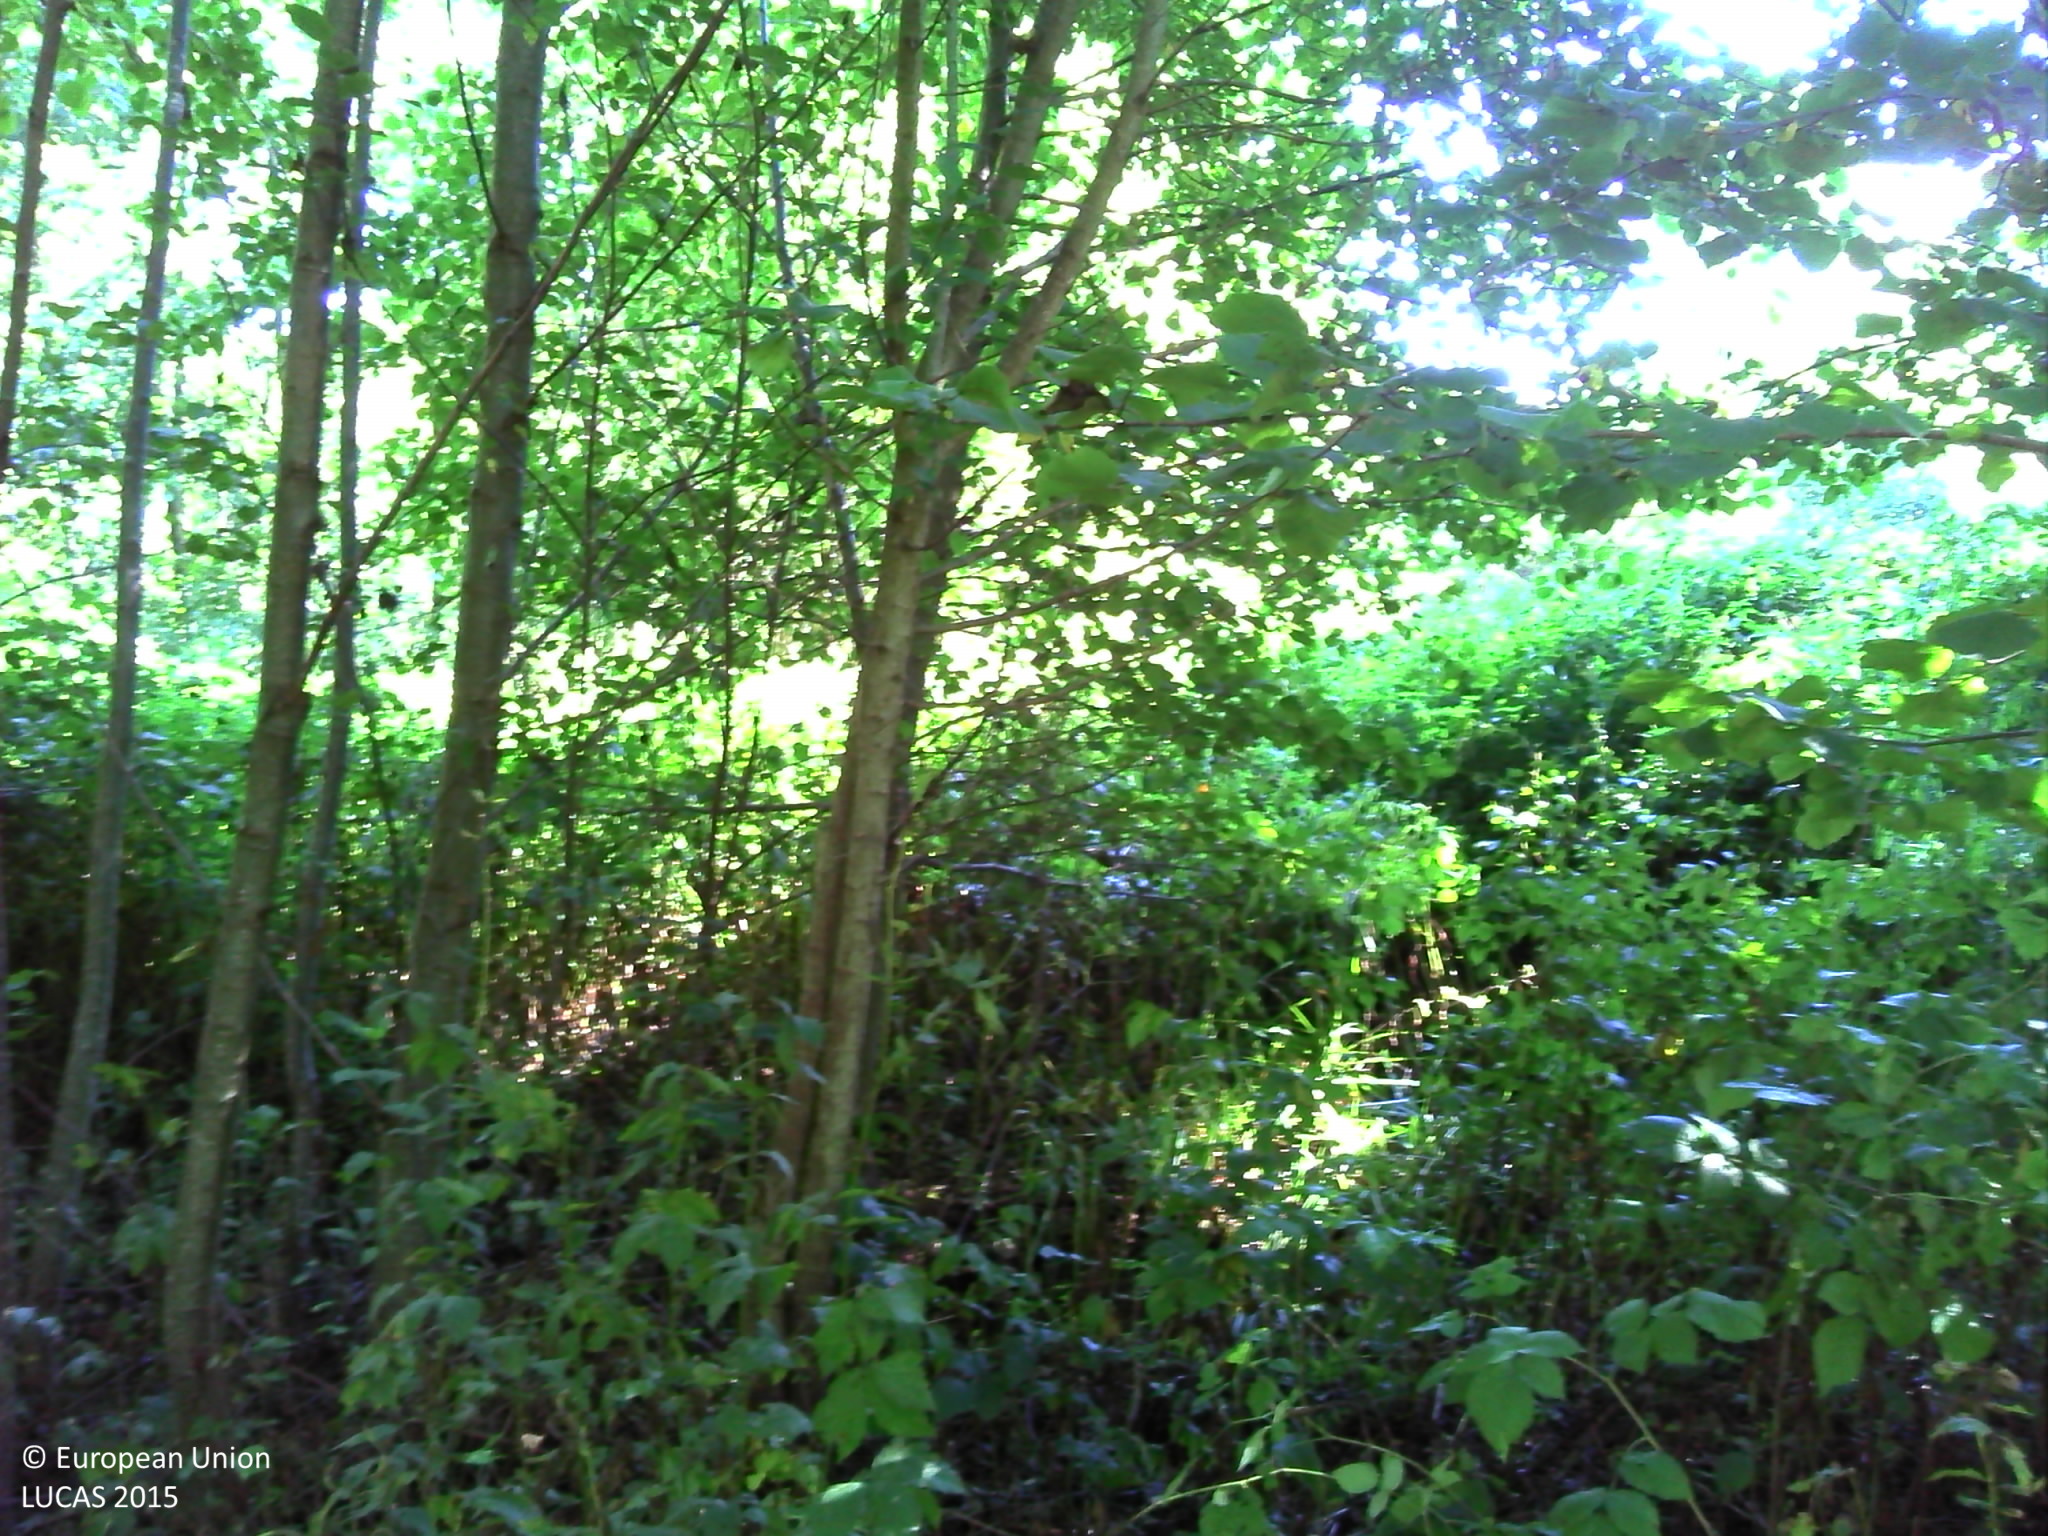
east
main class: Woodland
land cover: Broadleaved woodland
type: non-riverine alder, birch or aspen forest
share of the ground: > 75 %
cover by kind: broadleaved forest trees 80 %, herbaceous plants 10 %, shrubs 5 %, unconsolidated bare surface 5 %
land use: Semi-natural and natural areas not in use
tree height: > 5 m
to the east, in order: Broadleaved woodland; Ditches and canals; Broadleaved woodland; Fences; Ditches and canals; Broadleaved woodland; Grassland without tree/shrub cover; Fences; Managed hedges; Grassland without tree/shrub cover; Fences; Broadleaved woodland; Grass margins; Paved roads, cycling and walking lanes; Grass margins; Electric lines; Broadleaved woodland; Grassland without tree/shrub cover
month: September
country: FR
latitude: 45.8963
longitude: 2.8713
